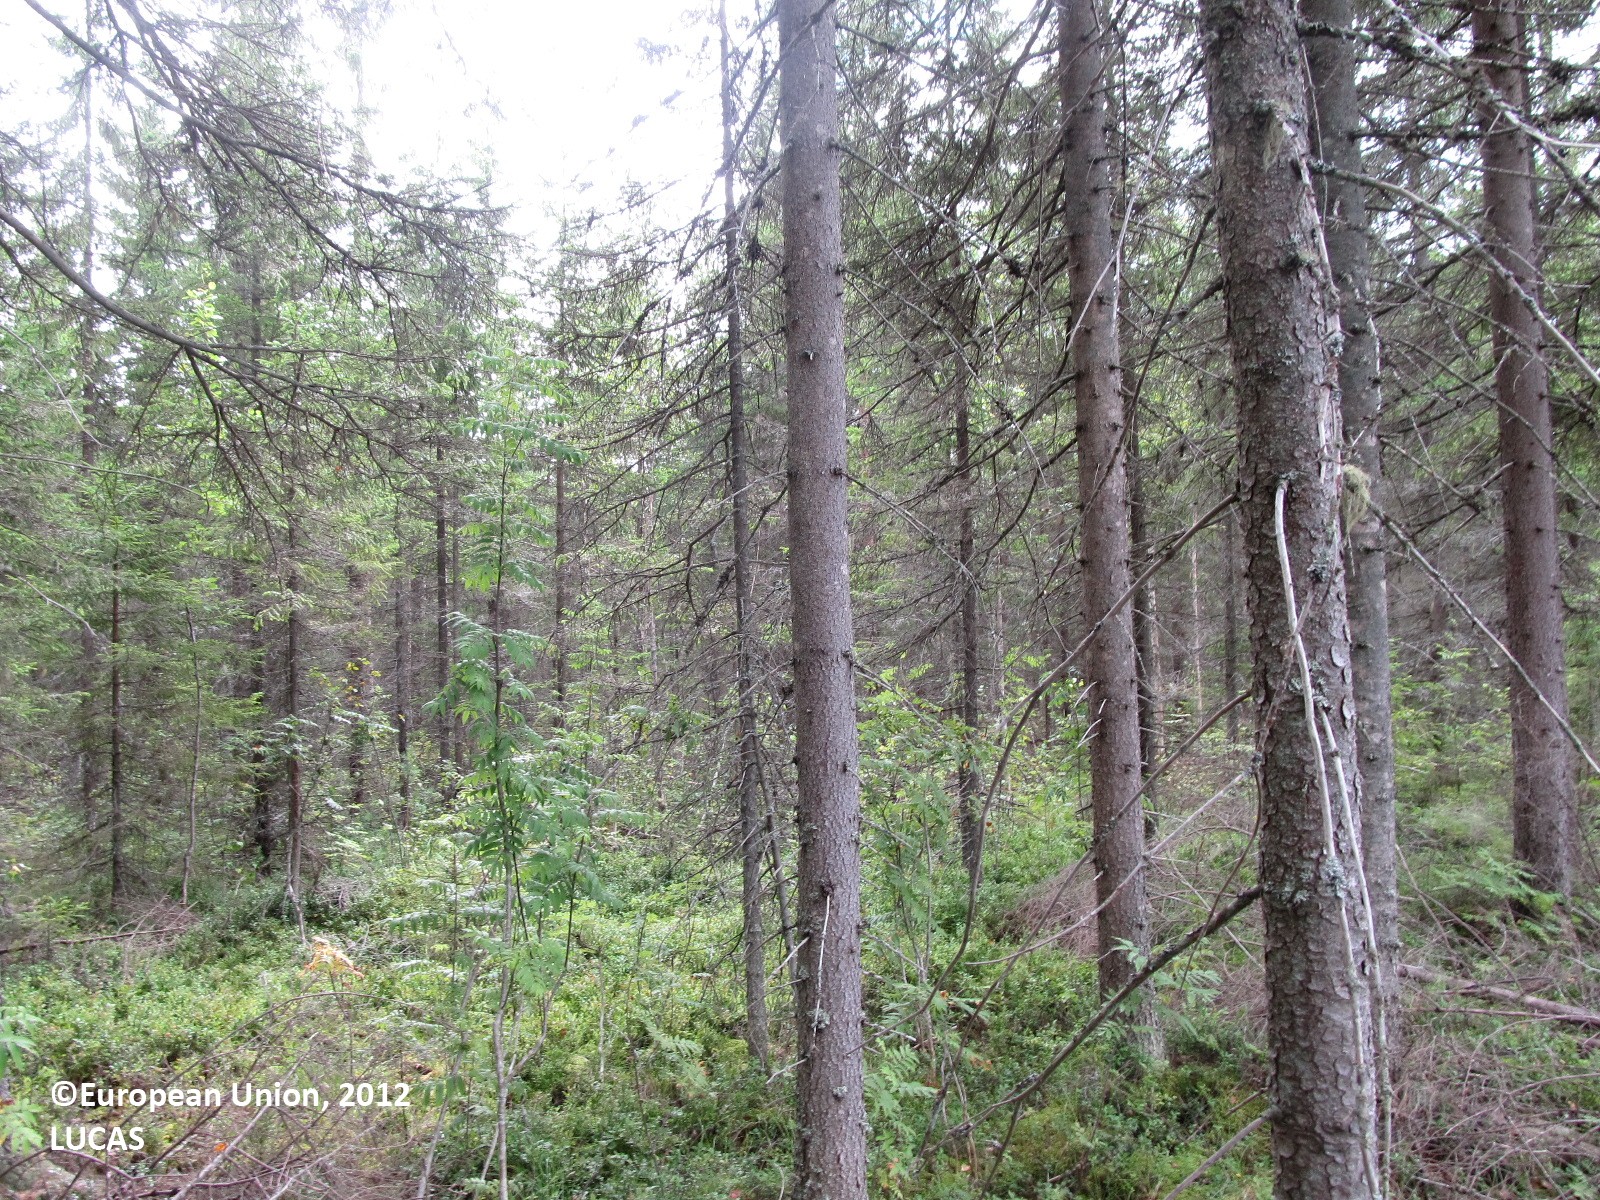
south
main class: Woodland
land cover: Spruce dominated coniferous woodland
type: boreal forest
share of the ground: 25 - 50 %
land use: Forestry
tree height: > 5 m
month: August
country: FI
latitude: 62.2954
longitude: 28.5809
